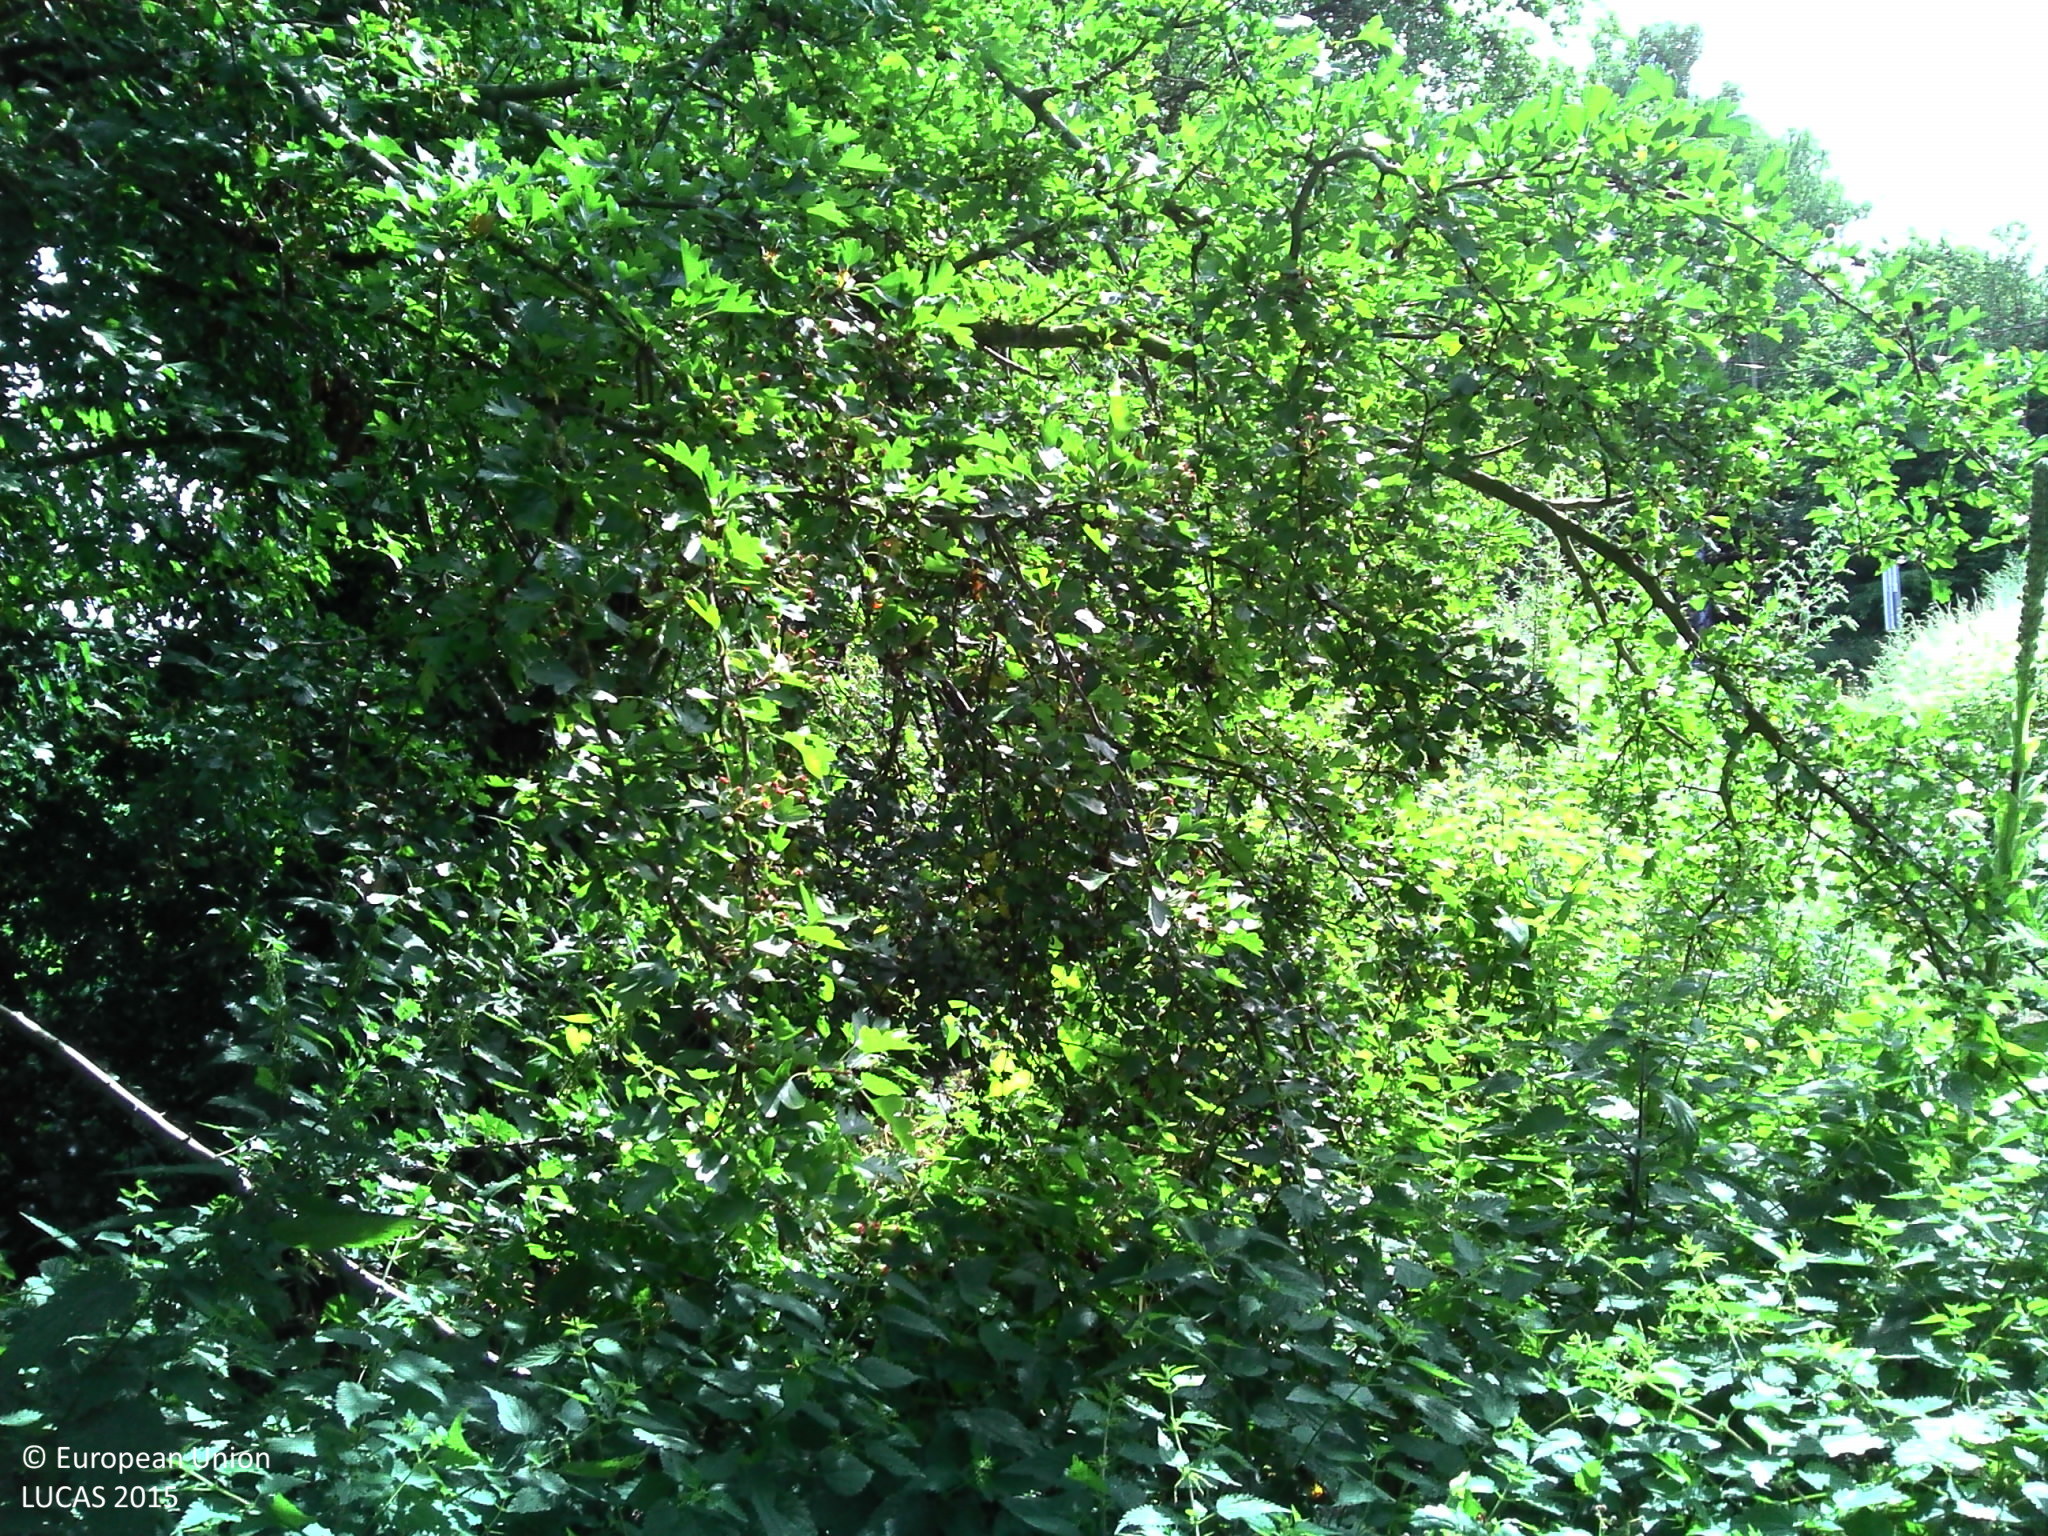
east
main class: Shrubland
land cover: Shrubland with sparse tree cover
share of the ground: > 75 %
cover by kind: shrubs 60 %, herbaceous plants 35 %, broadleaved forest trees 5 %
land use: Abandoned areas
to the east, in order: Shrubland with sparse tree cover; Spontaneously vegetated surfaces; Abandoned hedges; Artificial constructions in urban areas; Potatoes
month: July
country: BE
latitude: 50.5756
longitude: 4.1628
